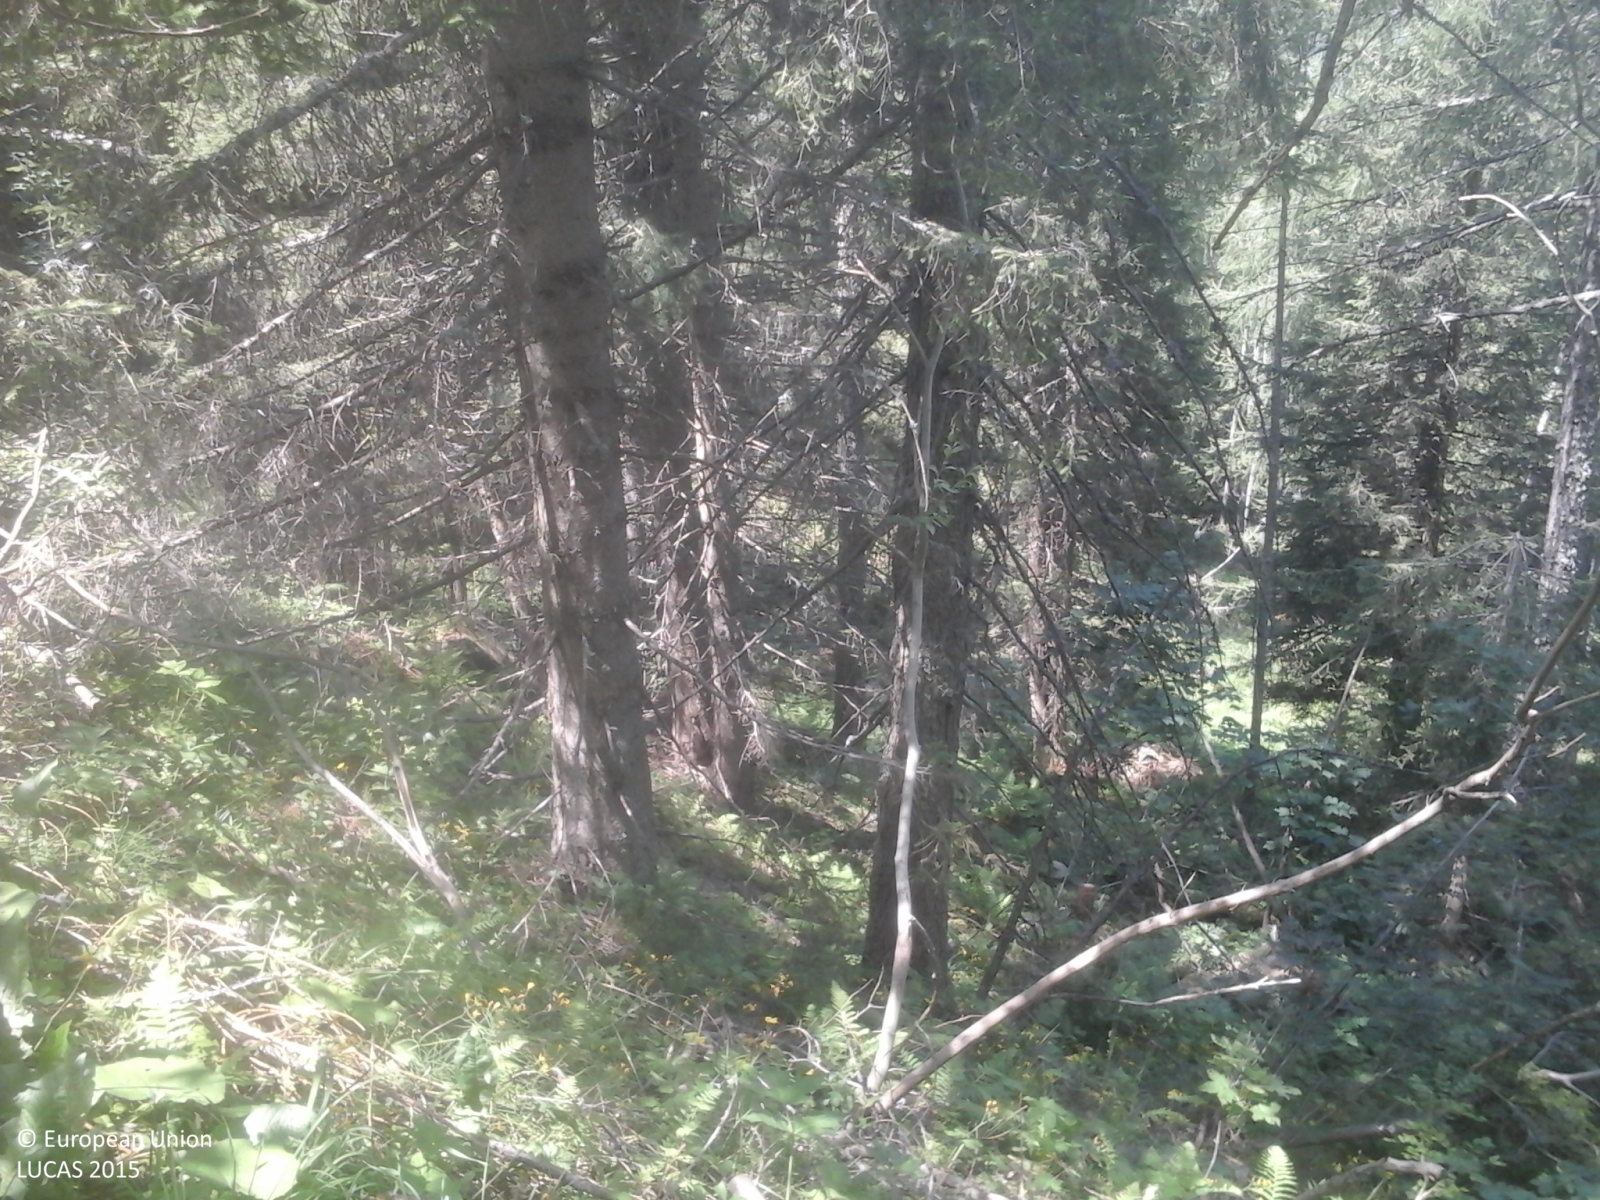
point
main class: Woodland
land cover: Spruce dominated mixed woodland
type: alpine coniferous forest
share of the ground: > 75 %
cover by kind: coniferous forest trees 75 %, broadleaved forest trees 25 %
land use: Forestry
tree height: > 5 m
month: July
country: IT
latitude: 46.3853
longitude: 9.3637
